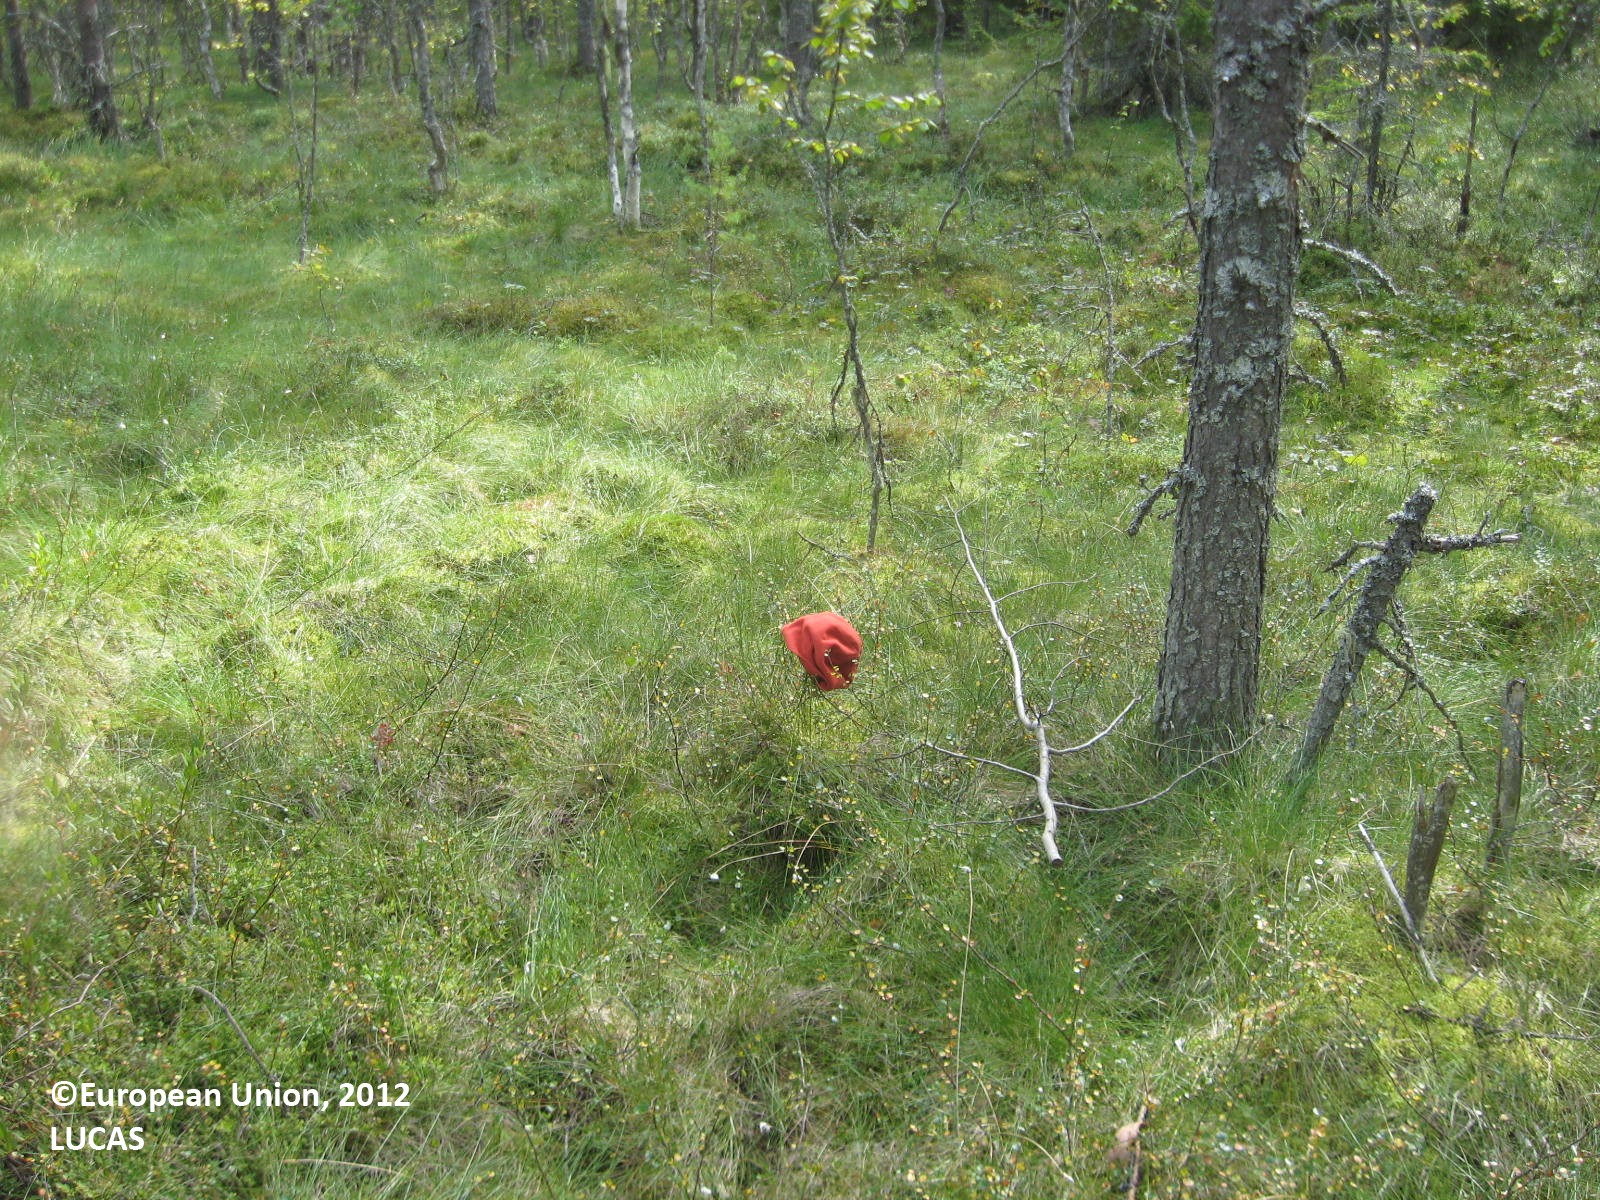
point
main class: Woodland
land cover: Pine dominated mixed woodland
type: boreal forest
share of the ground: 50 - 75 %
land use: Forestry
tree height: > 5 m
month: August
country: FI
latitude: 63.8425
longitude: 29.0525
